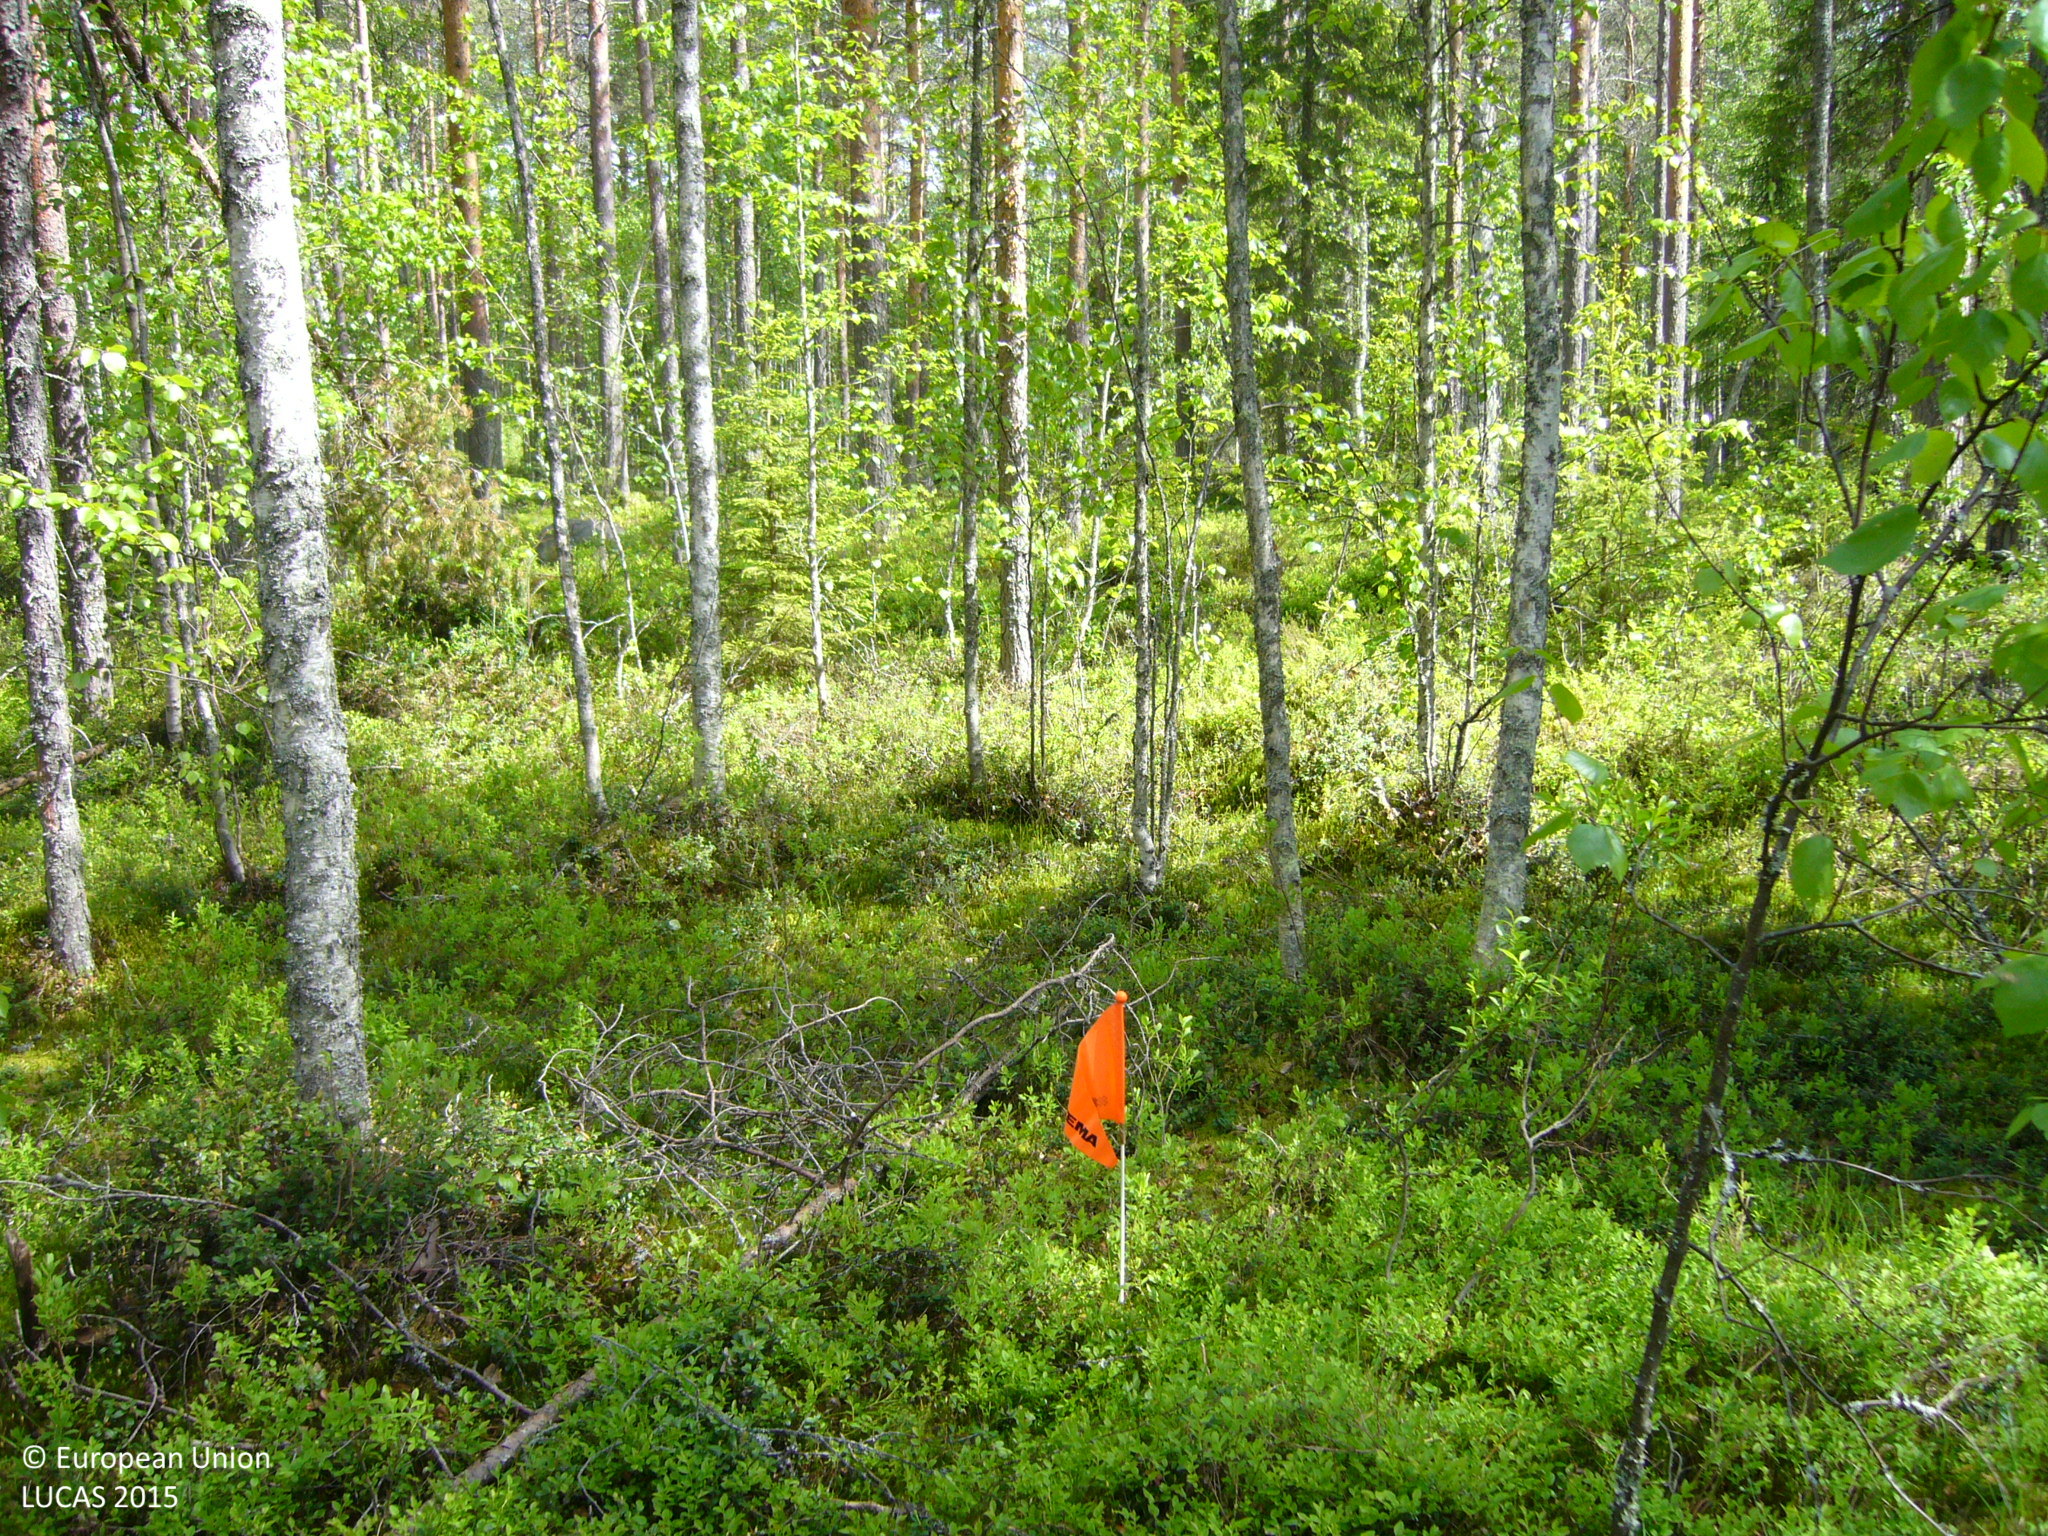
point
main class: Woodland
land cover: Pine dominated mixed woodland
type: boreal forest
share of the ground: > 75 %
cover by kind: coniferous forest trees 50 %, broadleaved forest trees 25 %, shrubs 25 %
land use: Forestry
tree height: > 5 m
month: June
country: FI
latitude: 63.7326
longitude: 25.7603
